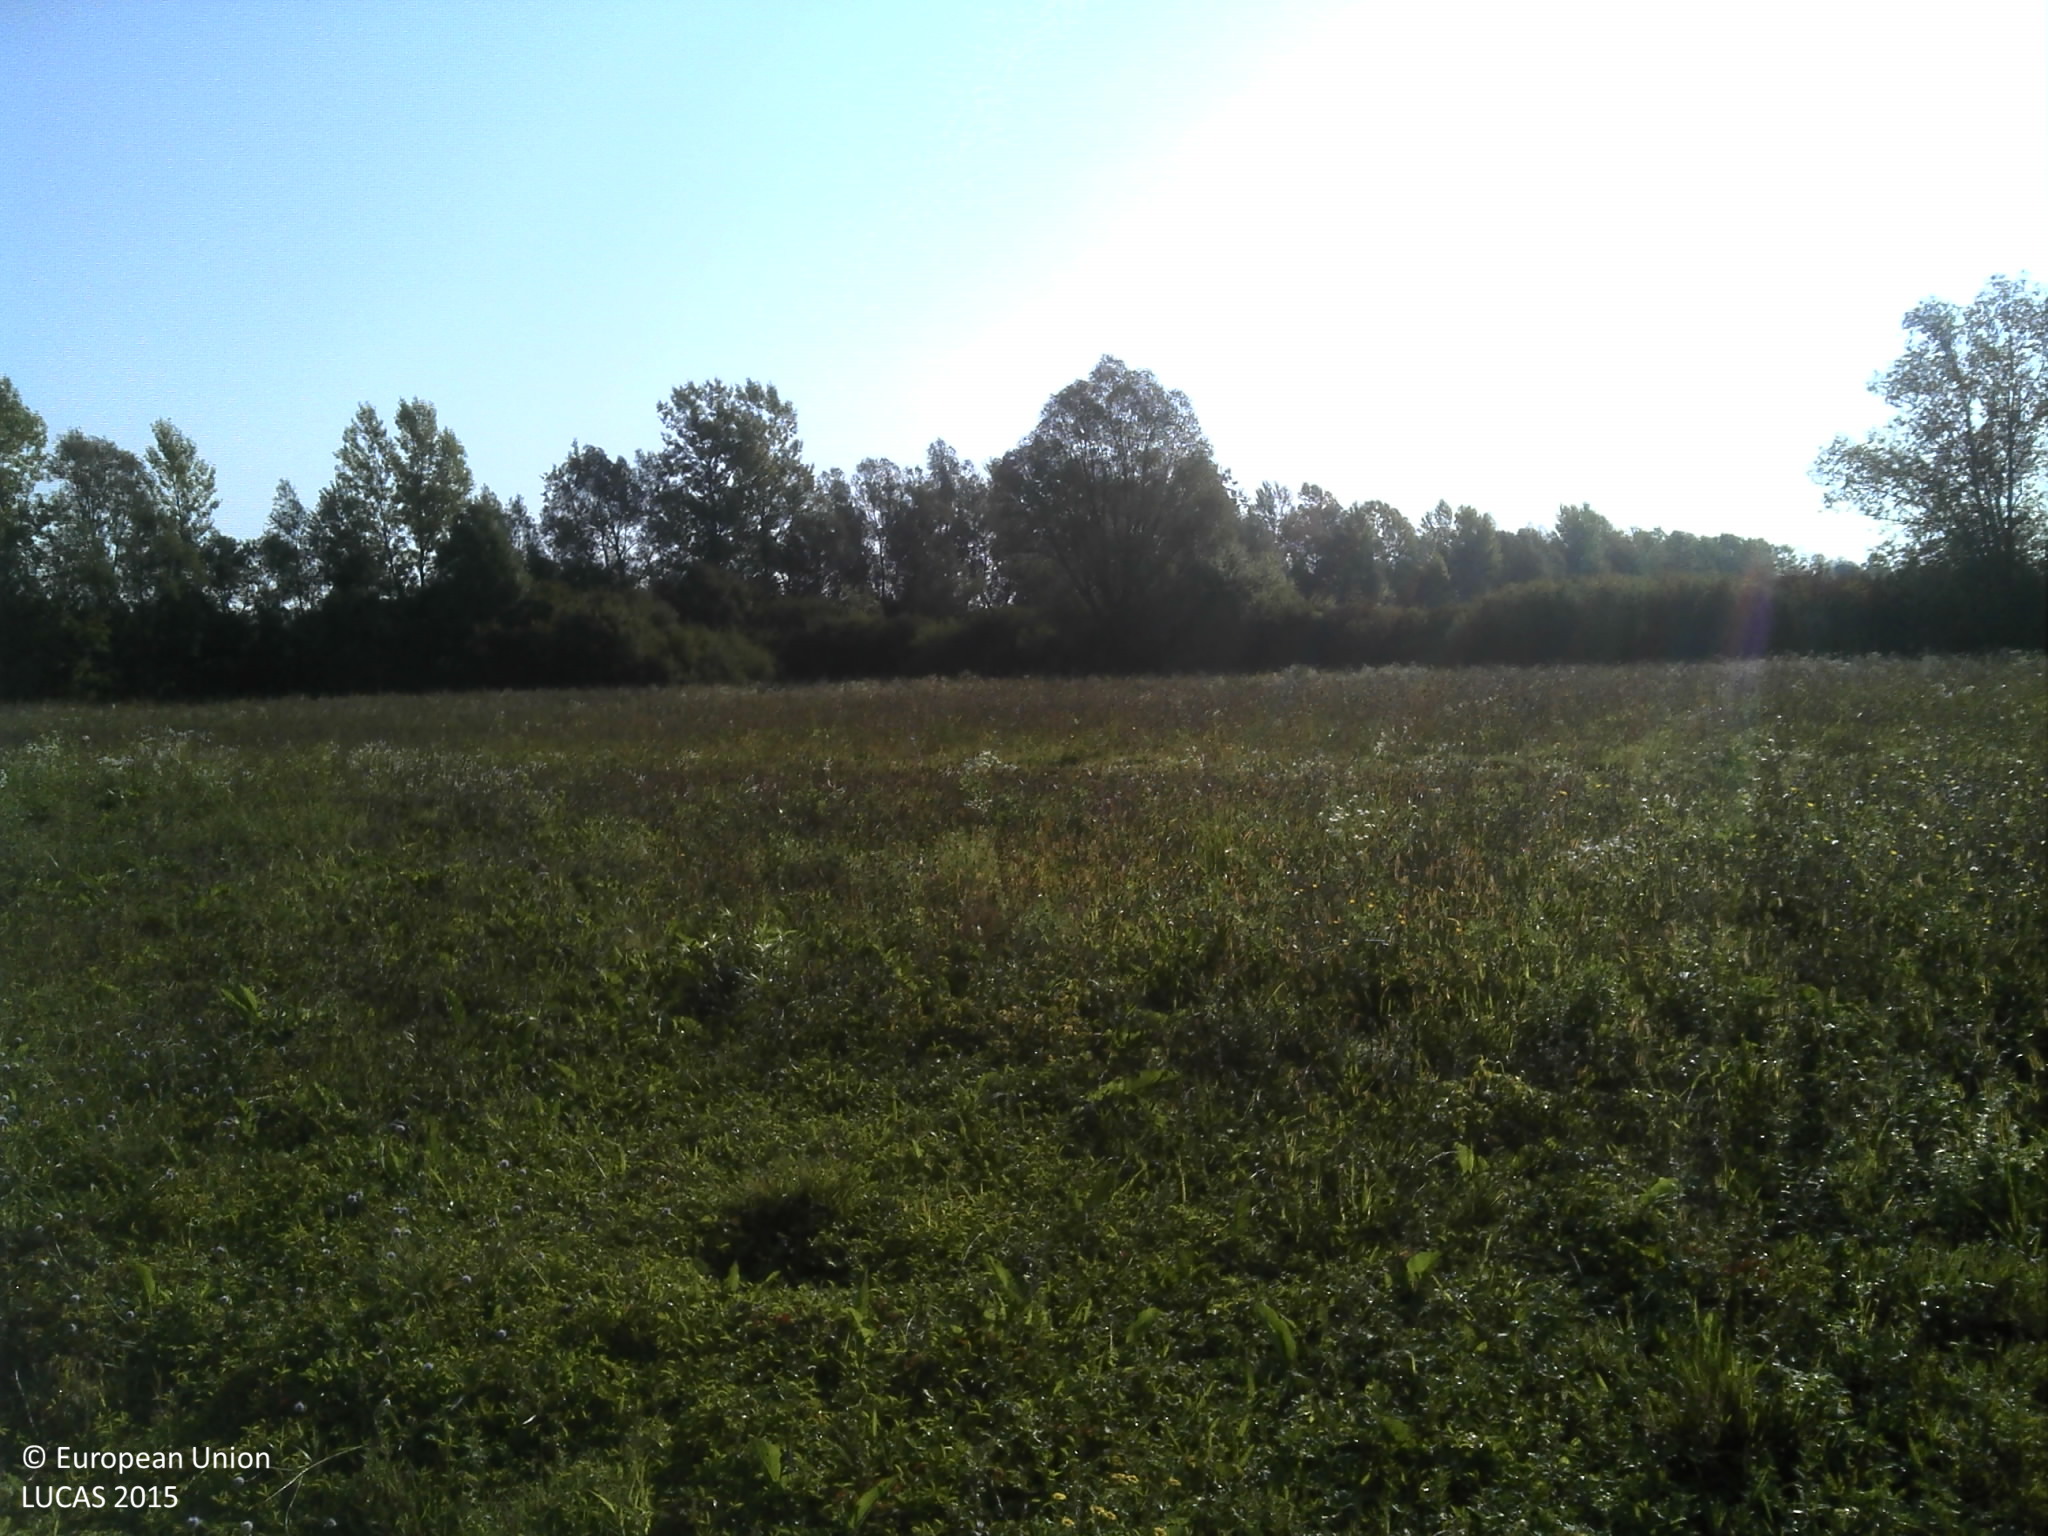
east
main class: Grassland
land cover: Grassland without tree/shrub cover
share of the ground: > 75 %
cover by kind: herbaceous plants 100 %
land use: Agriculture (excluding fallow land and kitchen gardens)
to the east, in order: Grassland without tree/shrub cover; Shrubland with sparse tree cover; Grassland without tree/shrub cover; Shrubland with sparse tree cover; Ditches and canals; Tracks; Soya
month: September
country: HR
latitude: 45.5817
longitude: 16.3935
